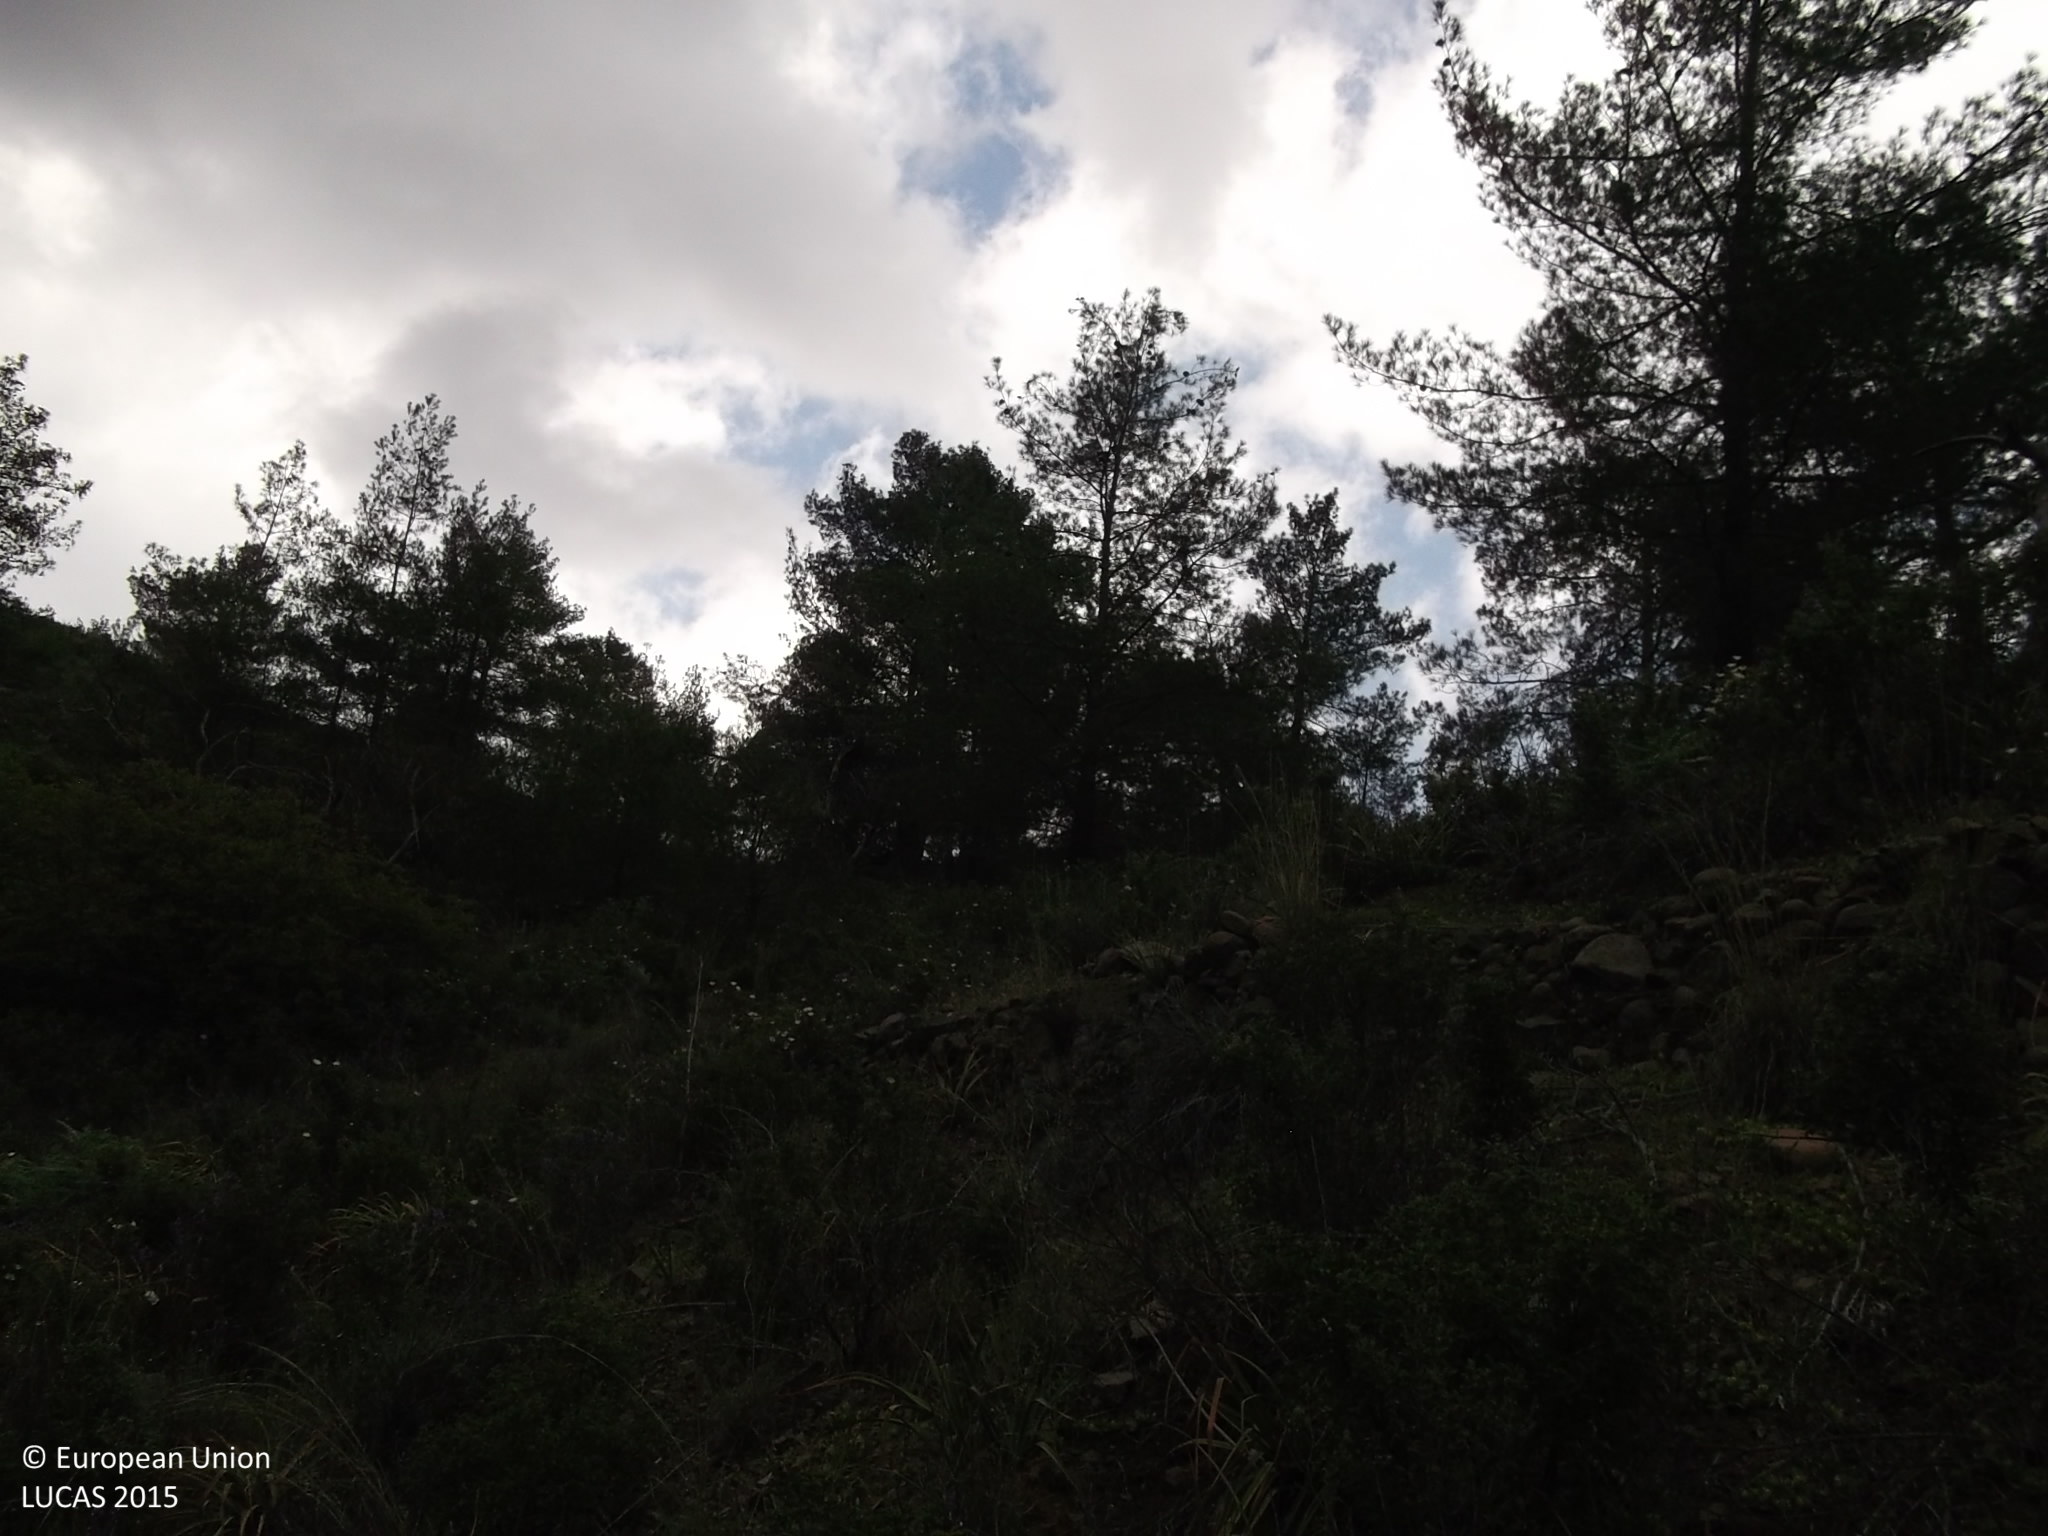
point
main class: Woodland
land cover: Pine dominated coniferous woodland
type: coniferous forest of the mediterranean region
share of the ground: 10 - 25 %
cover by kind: shrubs 30 %, coniferous forest trees 25 %, unconsolidated bare surface 25 %, consolidated bare surface 20 %
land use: Semi-natural and natural areas not in use
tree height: > 5 m
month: April
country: CY
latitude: 34.9514
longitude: 33.1177
